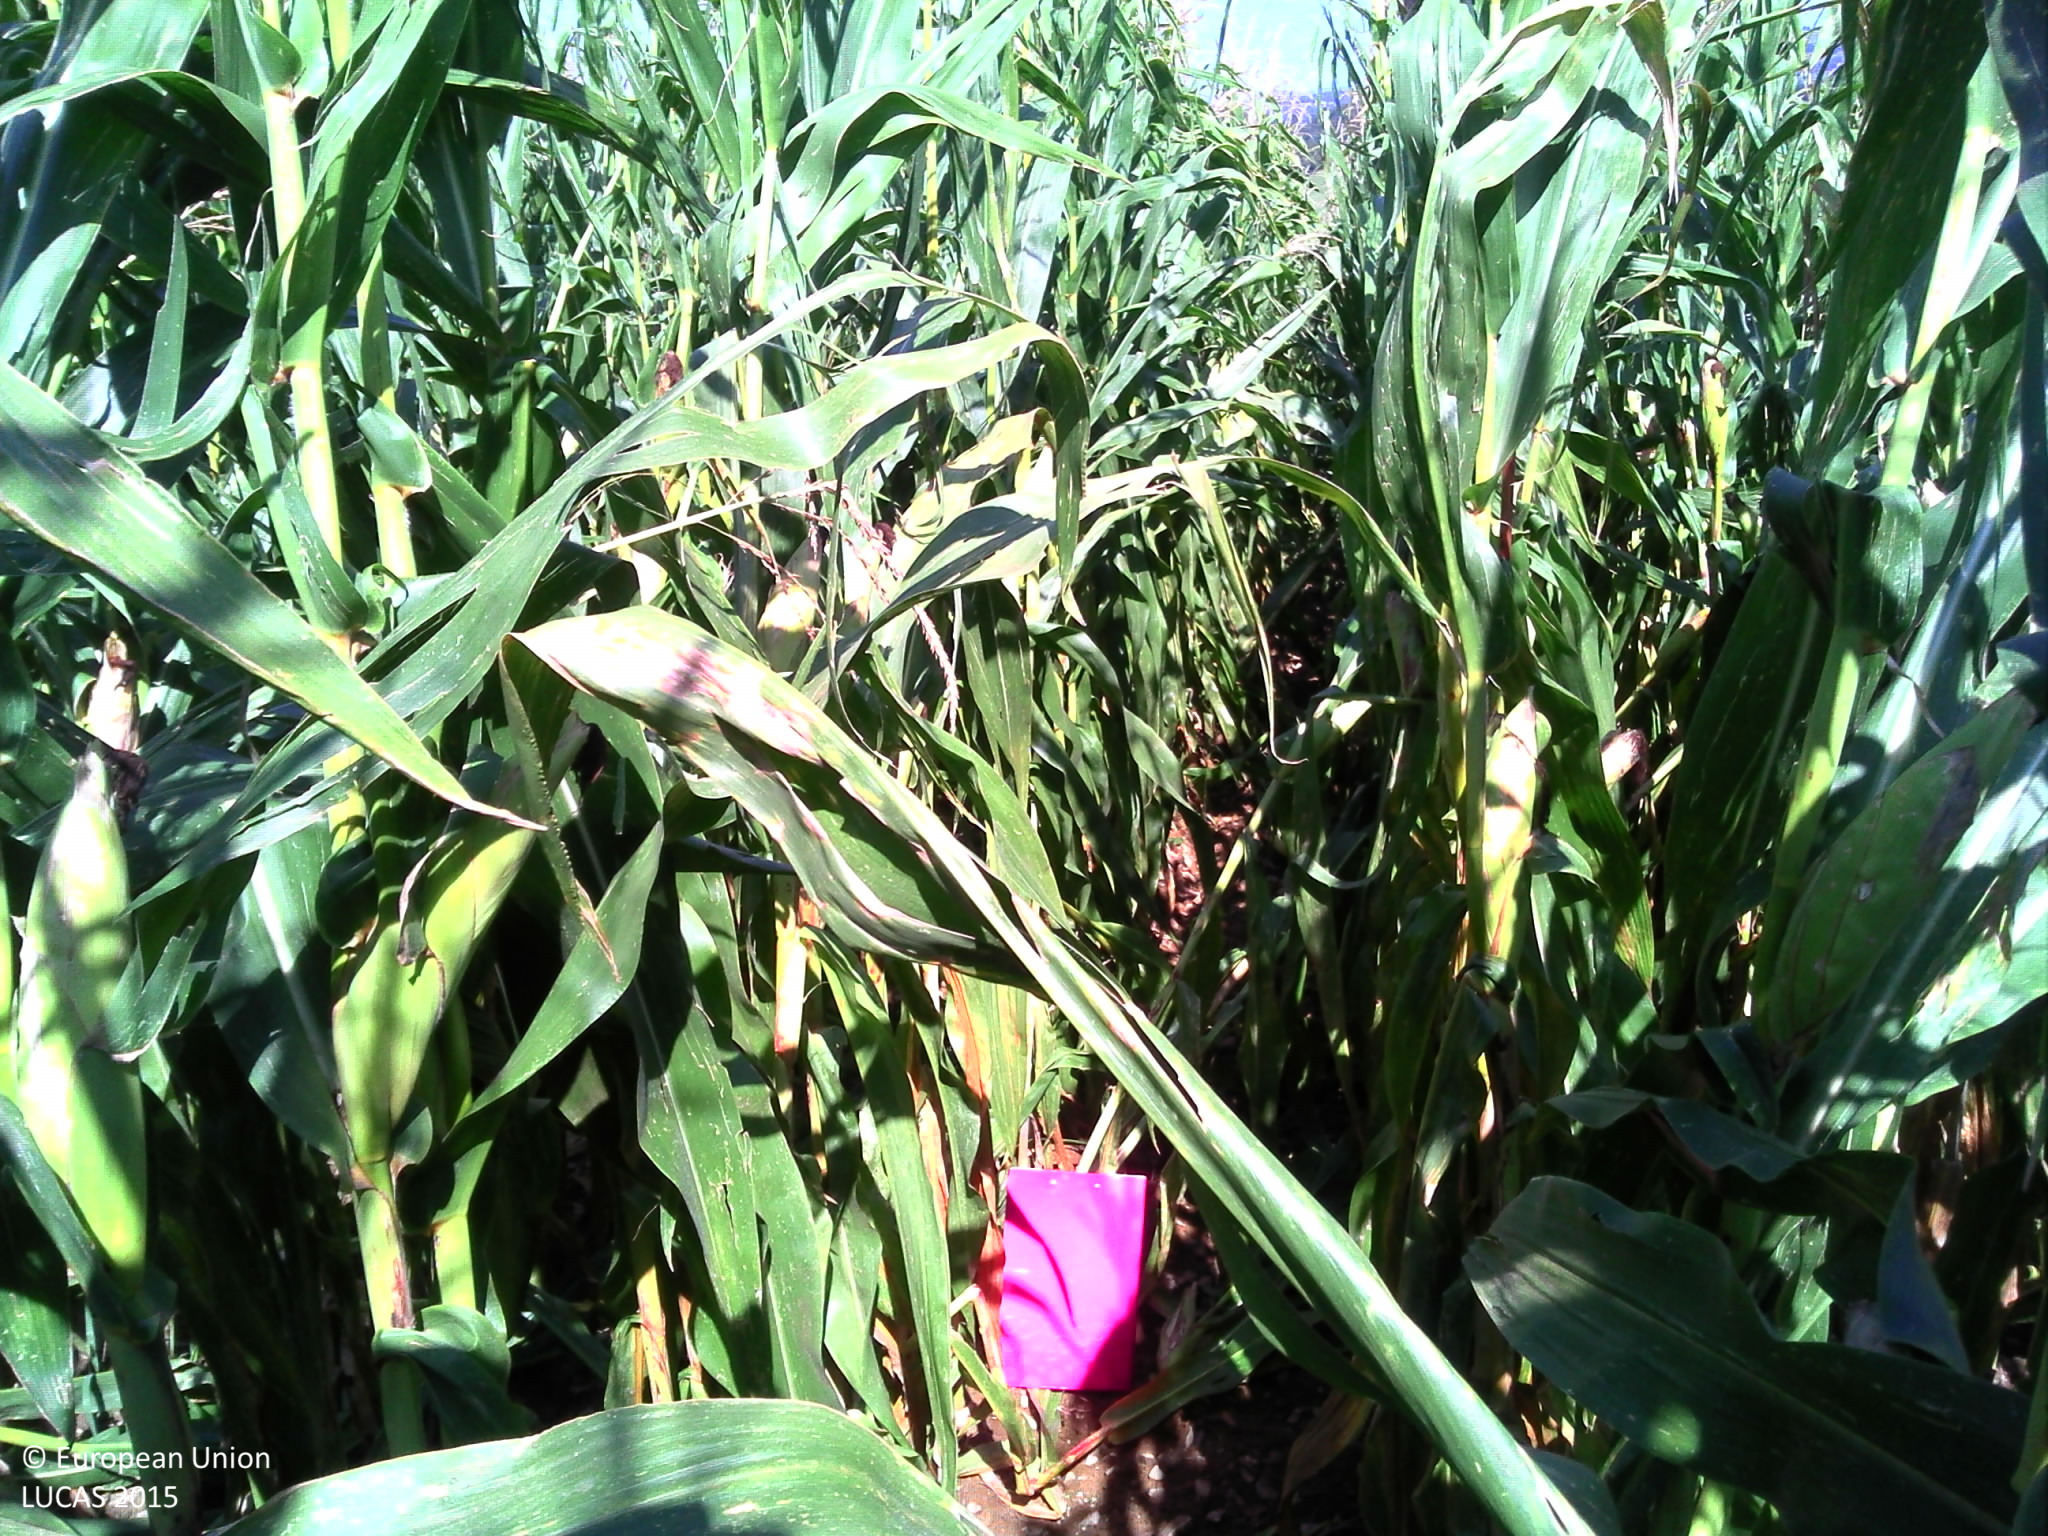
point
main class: Cropland
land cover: Maize
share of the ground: > 75 %
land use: Agriculture (excluding fallow land and kitchen gardens)
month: September
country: FR
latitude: 43.2638
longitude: -0.9139
